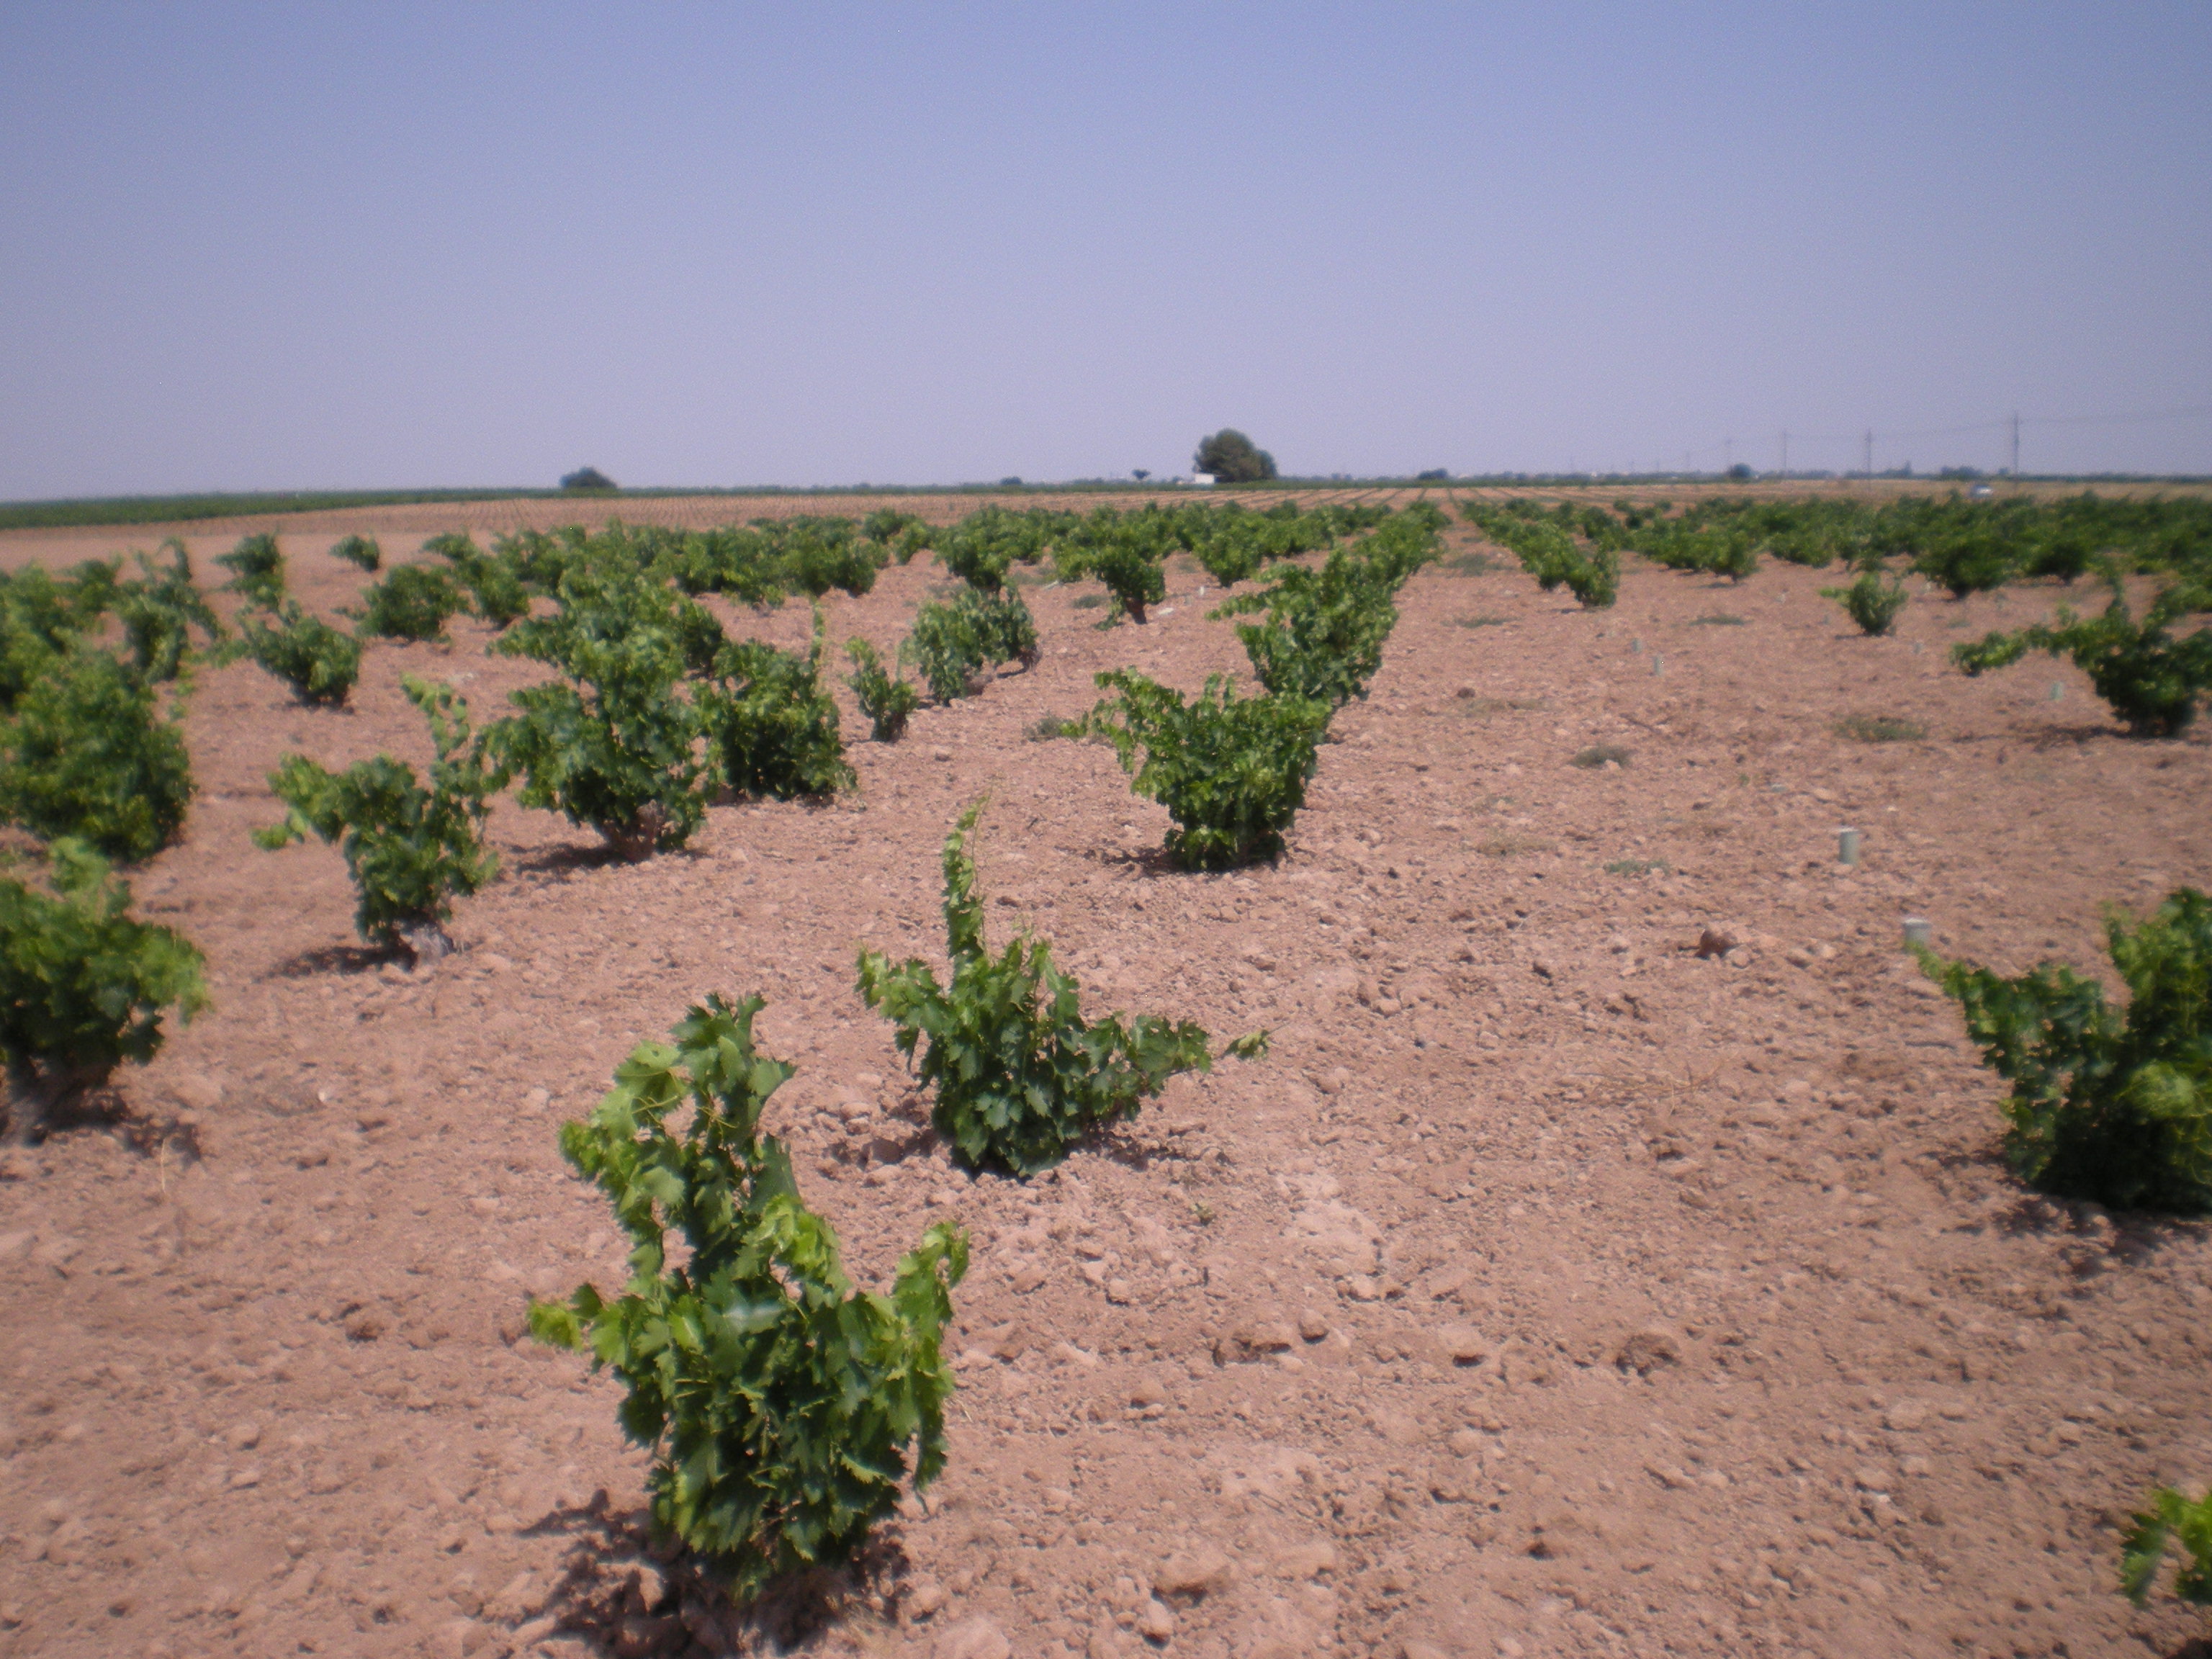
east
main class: Cropland
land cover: Vineyards
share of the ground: < 10 %
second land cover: Other bare soil
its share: > 75 %
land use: Agriculture (excluding fallow land and kitchen gardens)
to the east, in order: Vineyards; Other bare soil
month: June
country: ES
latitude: 39.6184
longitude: -3.2662
